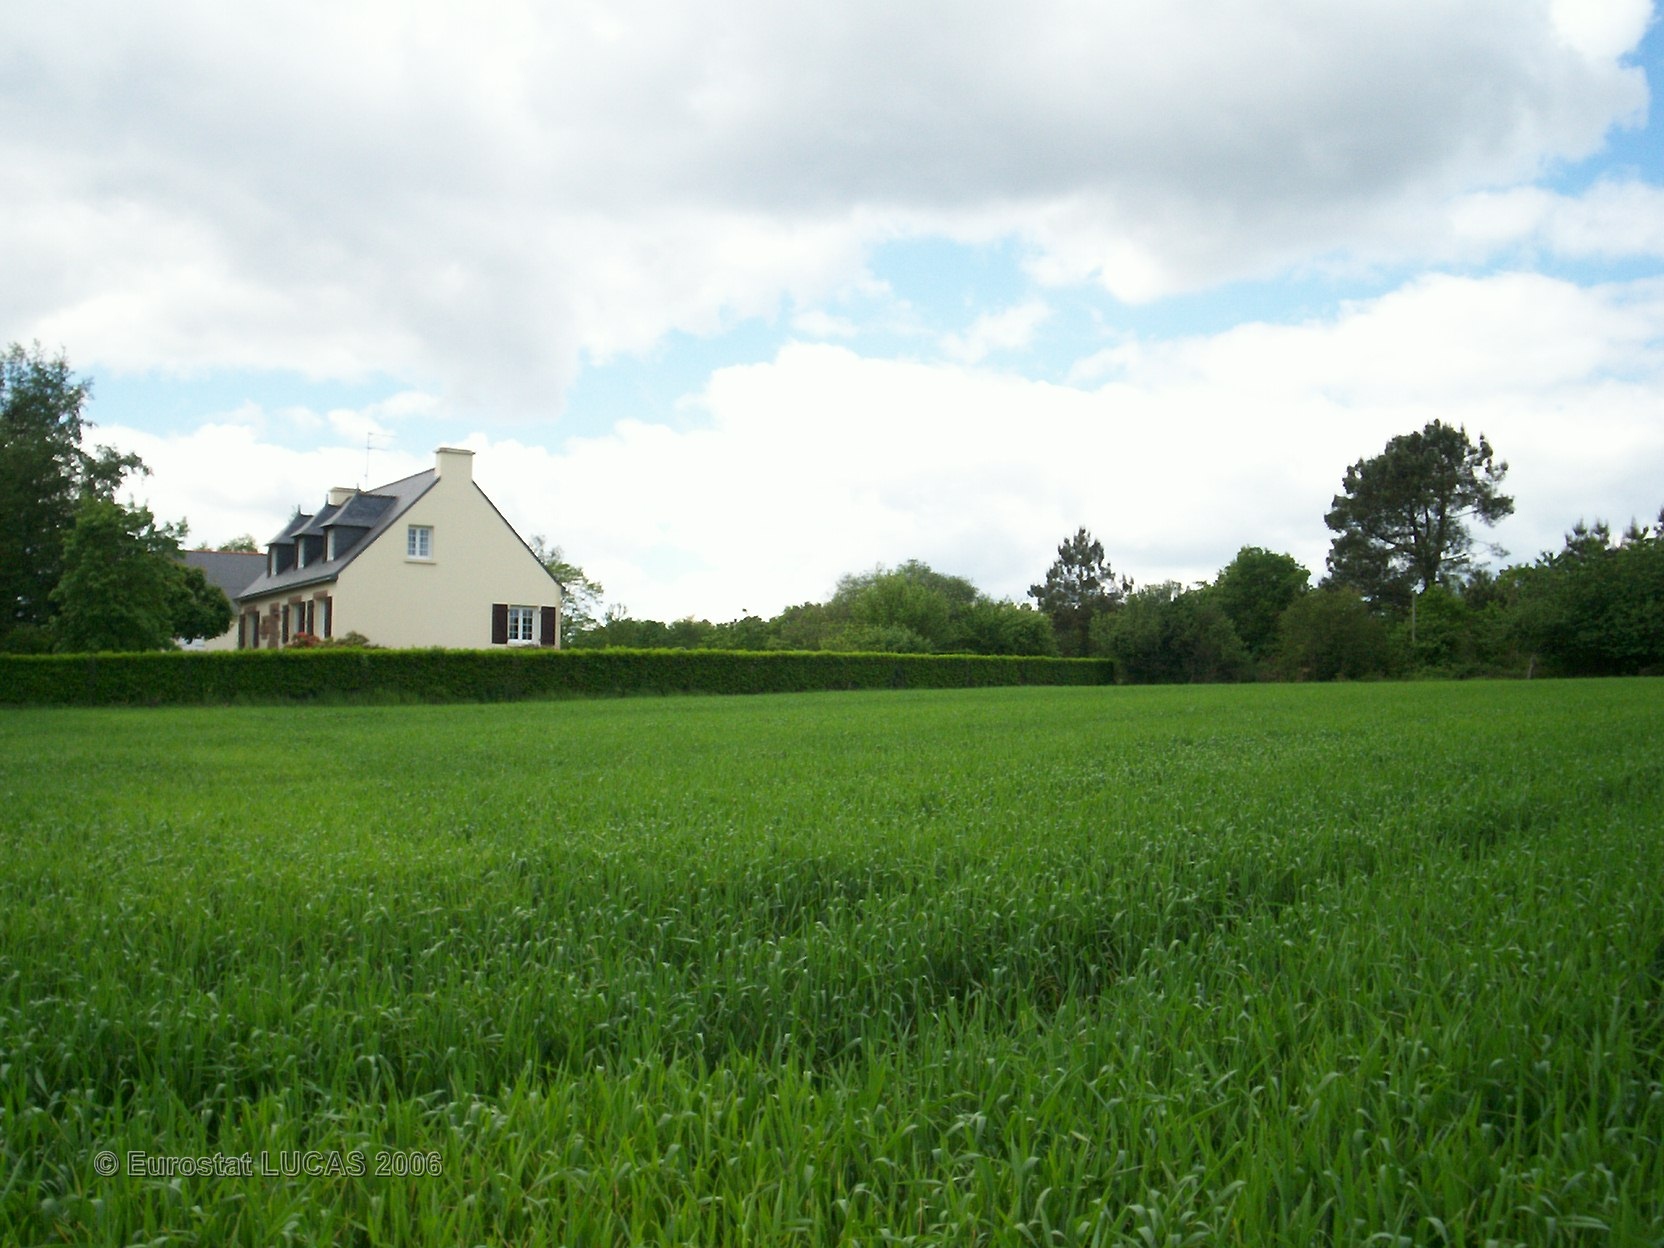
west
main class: Cropland
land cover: Common wheat
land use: Agriculture (excluding fallow land and kitchen gardens)
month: May
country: FR
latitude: 47.7415
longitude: -2.6908
